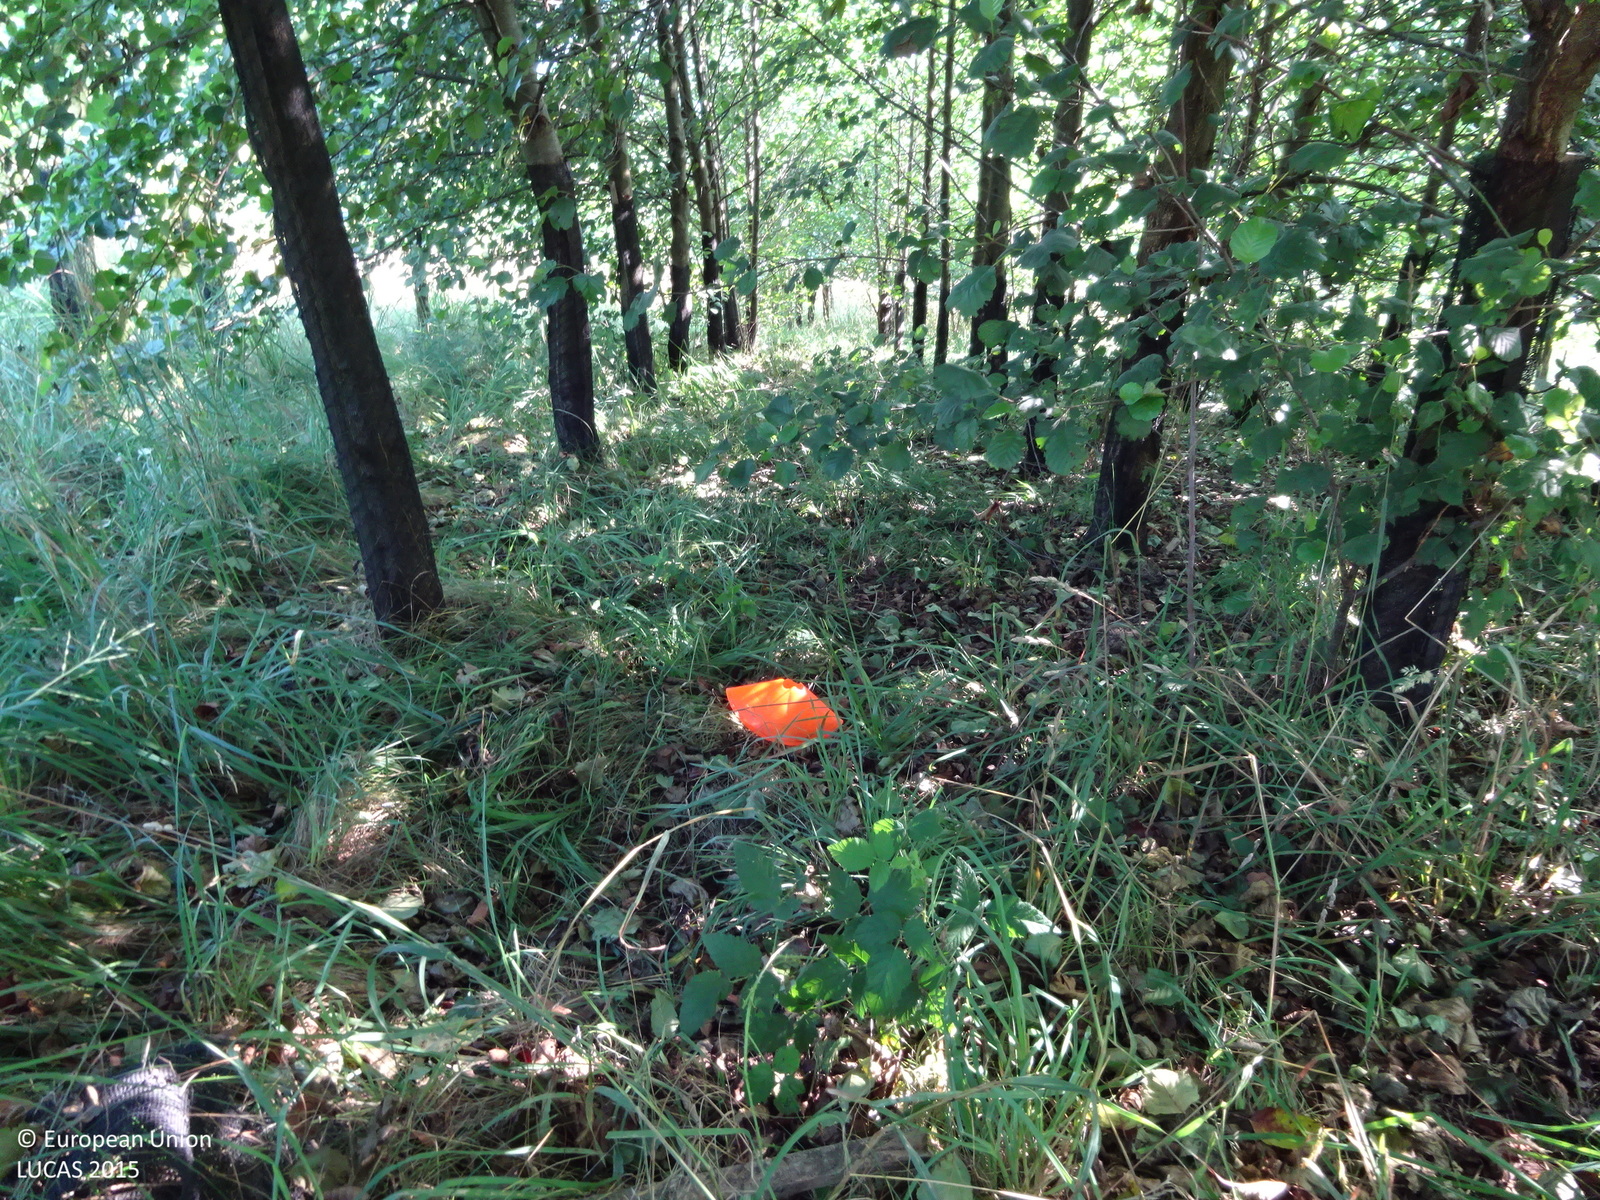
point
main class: Woodland
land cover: Broadleaved woodland
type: hemiboreal forest and nemoral coniferous forest and mixed broadleaved-coniferous forest
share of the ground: > 75 %
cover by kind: broadleaved forest trees 100 %
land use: Forestry
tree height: > 5 m
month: July
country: AT
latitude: 46.8790
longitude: 15.4712
